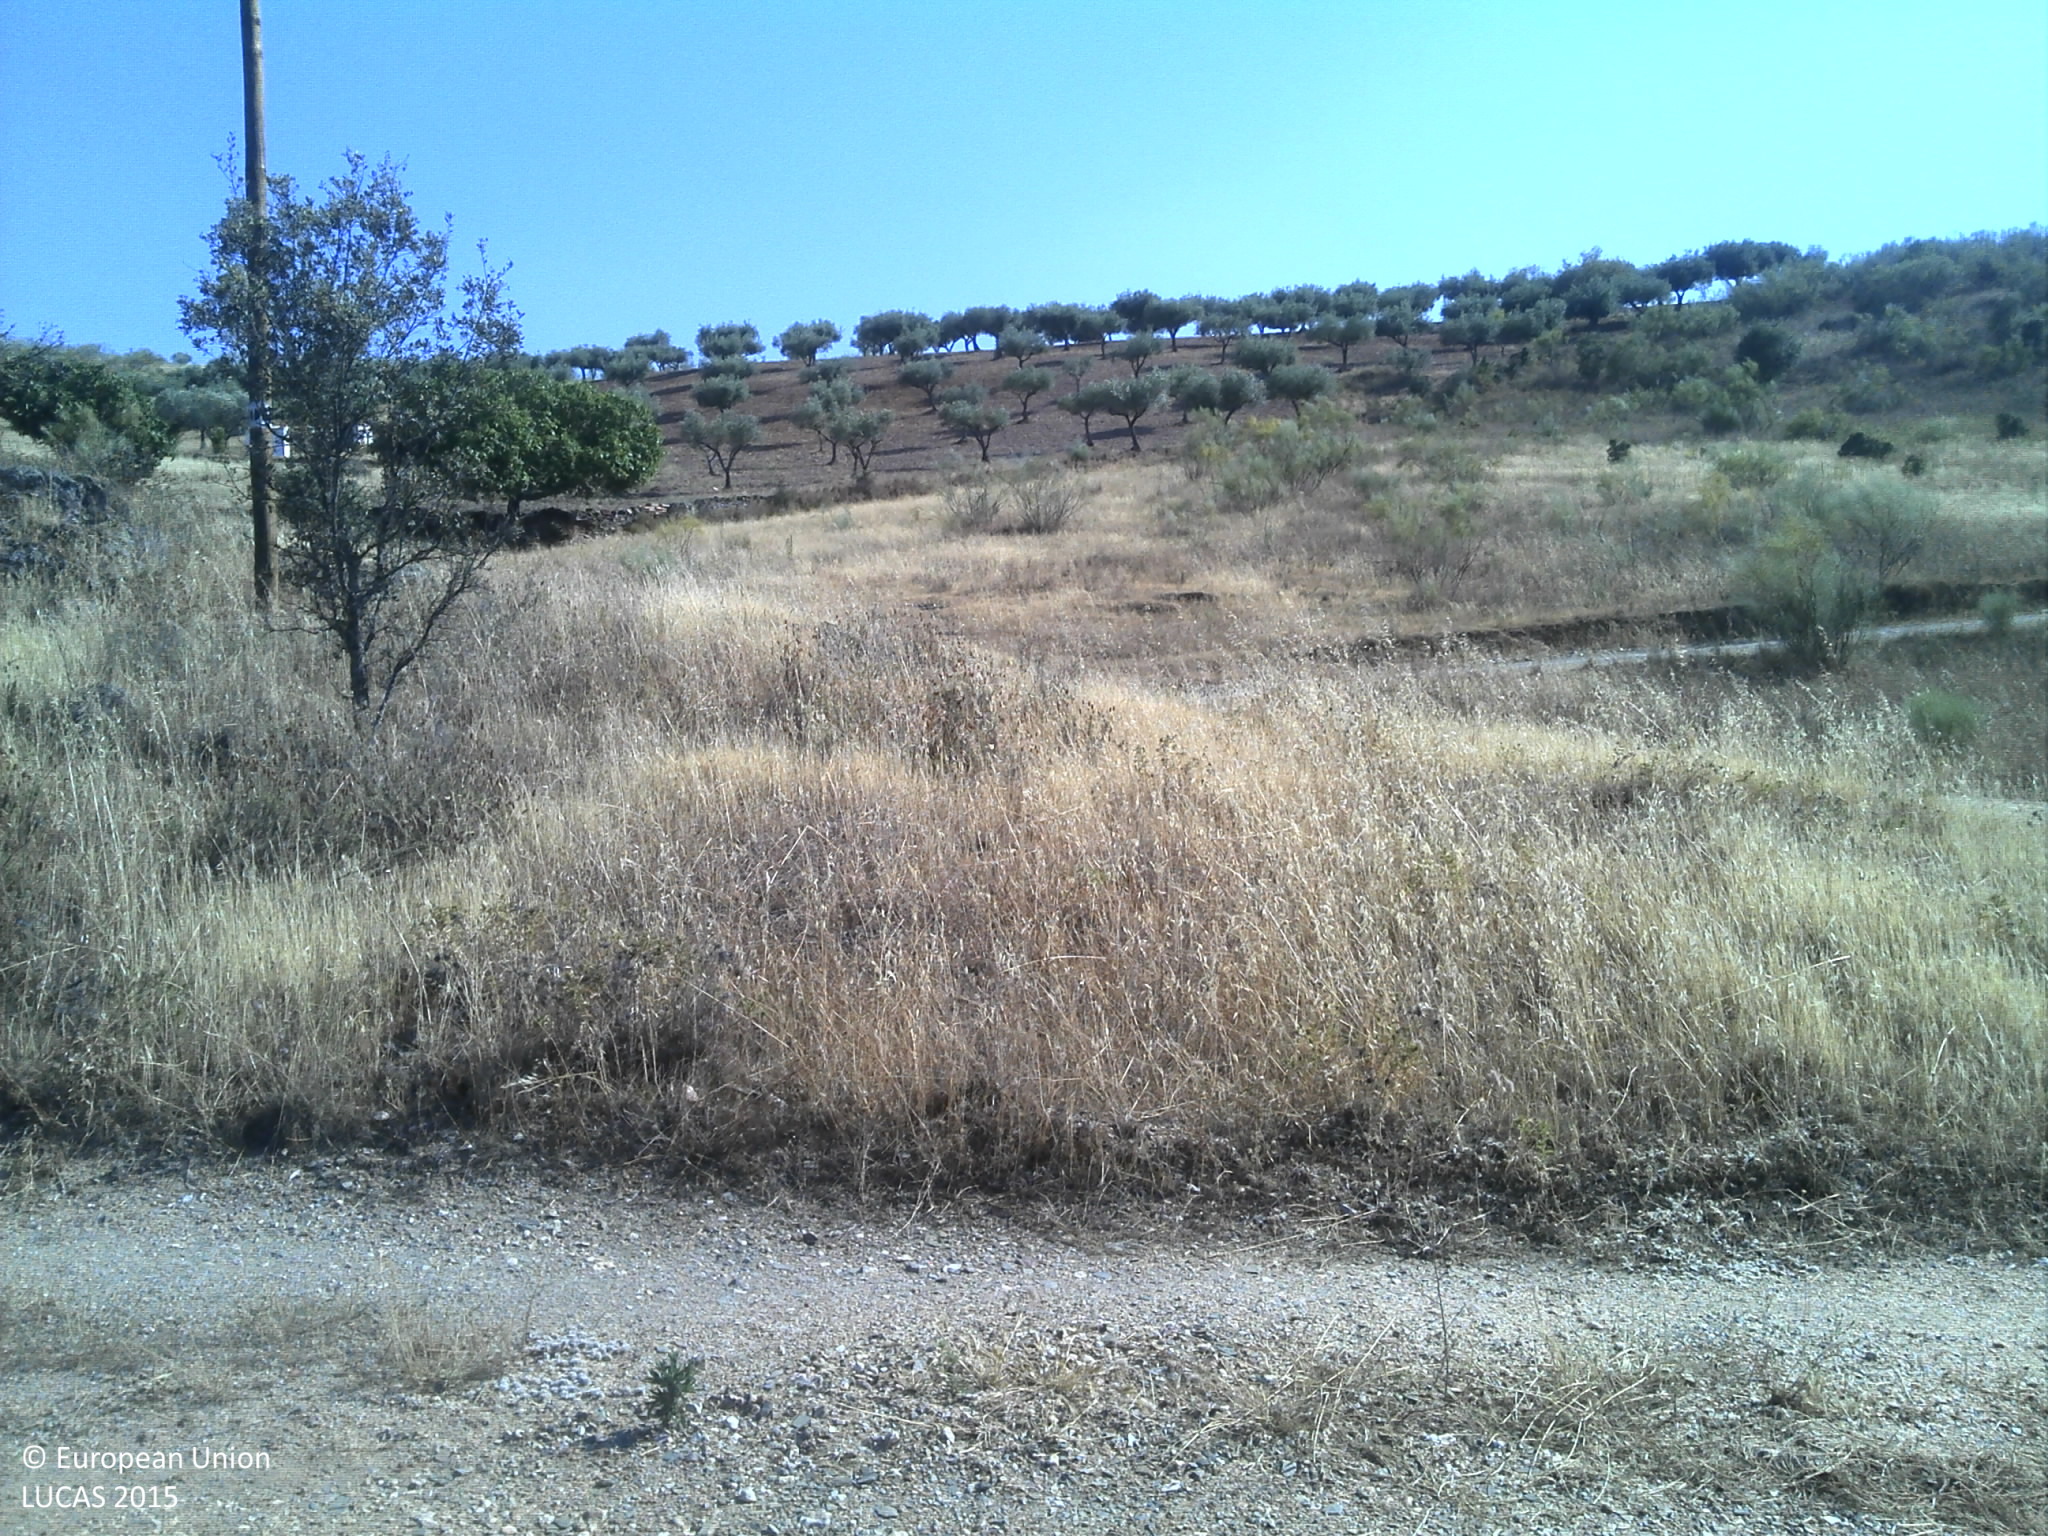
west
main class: Grassland
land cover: Grassland without tree/shrub cover
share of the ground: 50 - 75 %
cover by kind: herbaceous plants 70 %, unconsolidated bare surface 20 %, shrubs 5 %
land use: Agriculture (excluding fallow land and kitchen gardens)
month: June
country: PT
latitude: 39.6993
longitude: -7.1745
